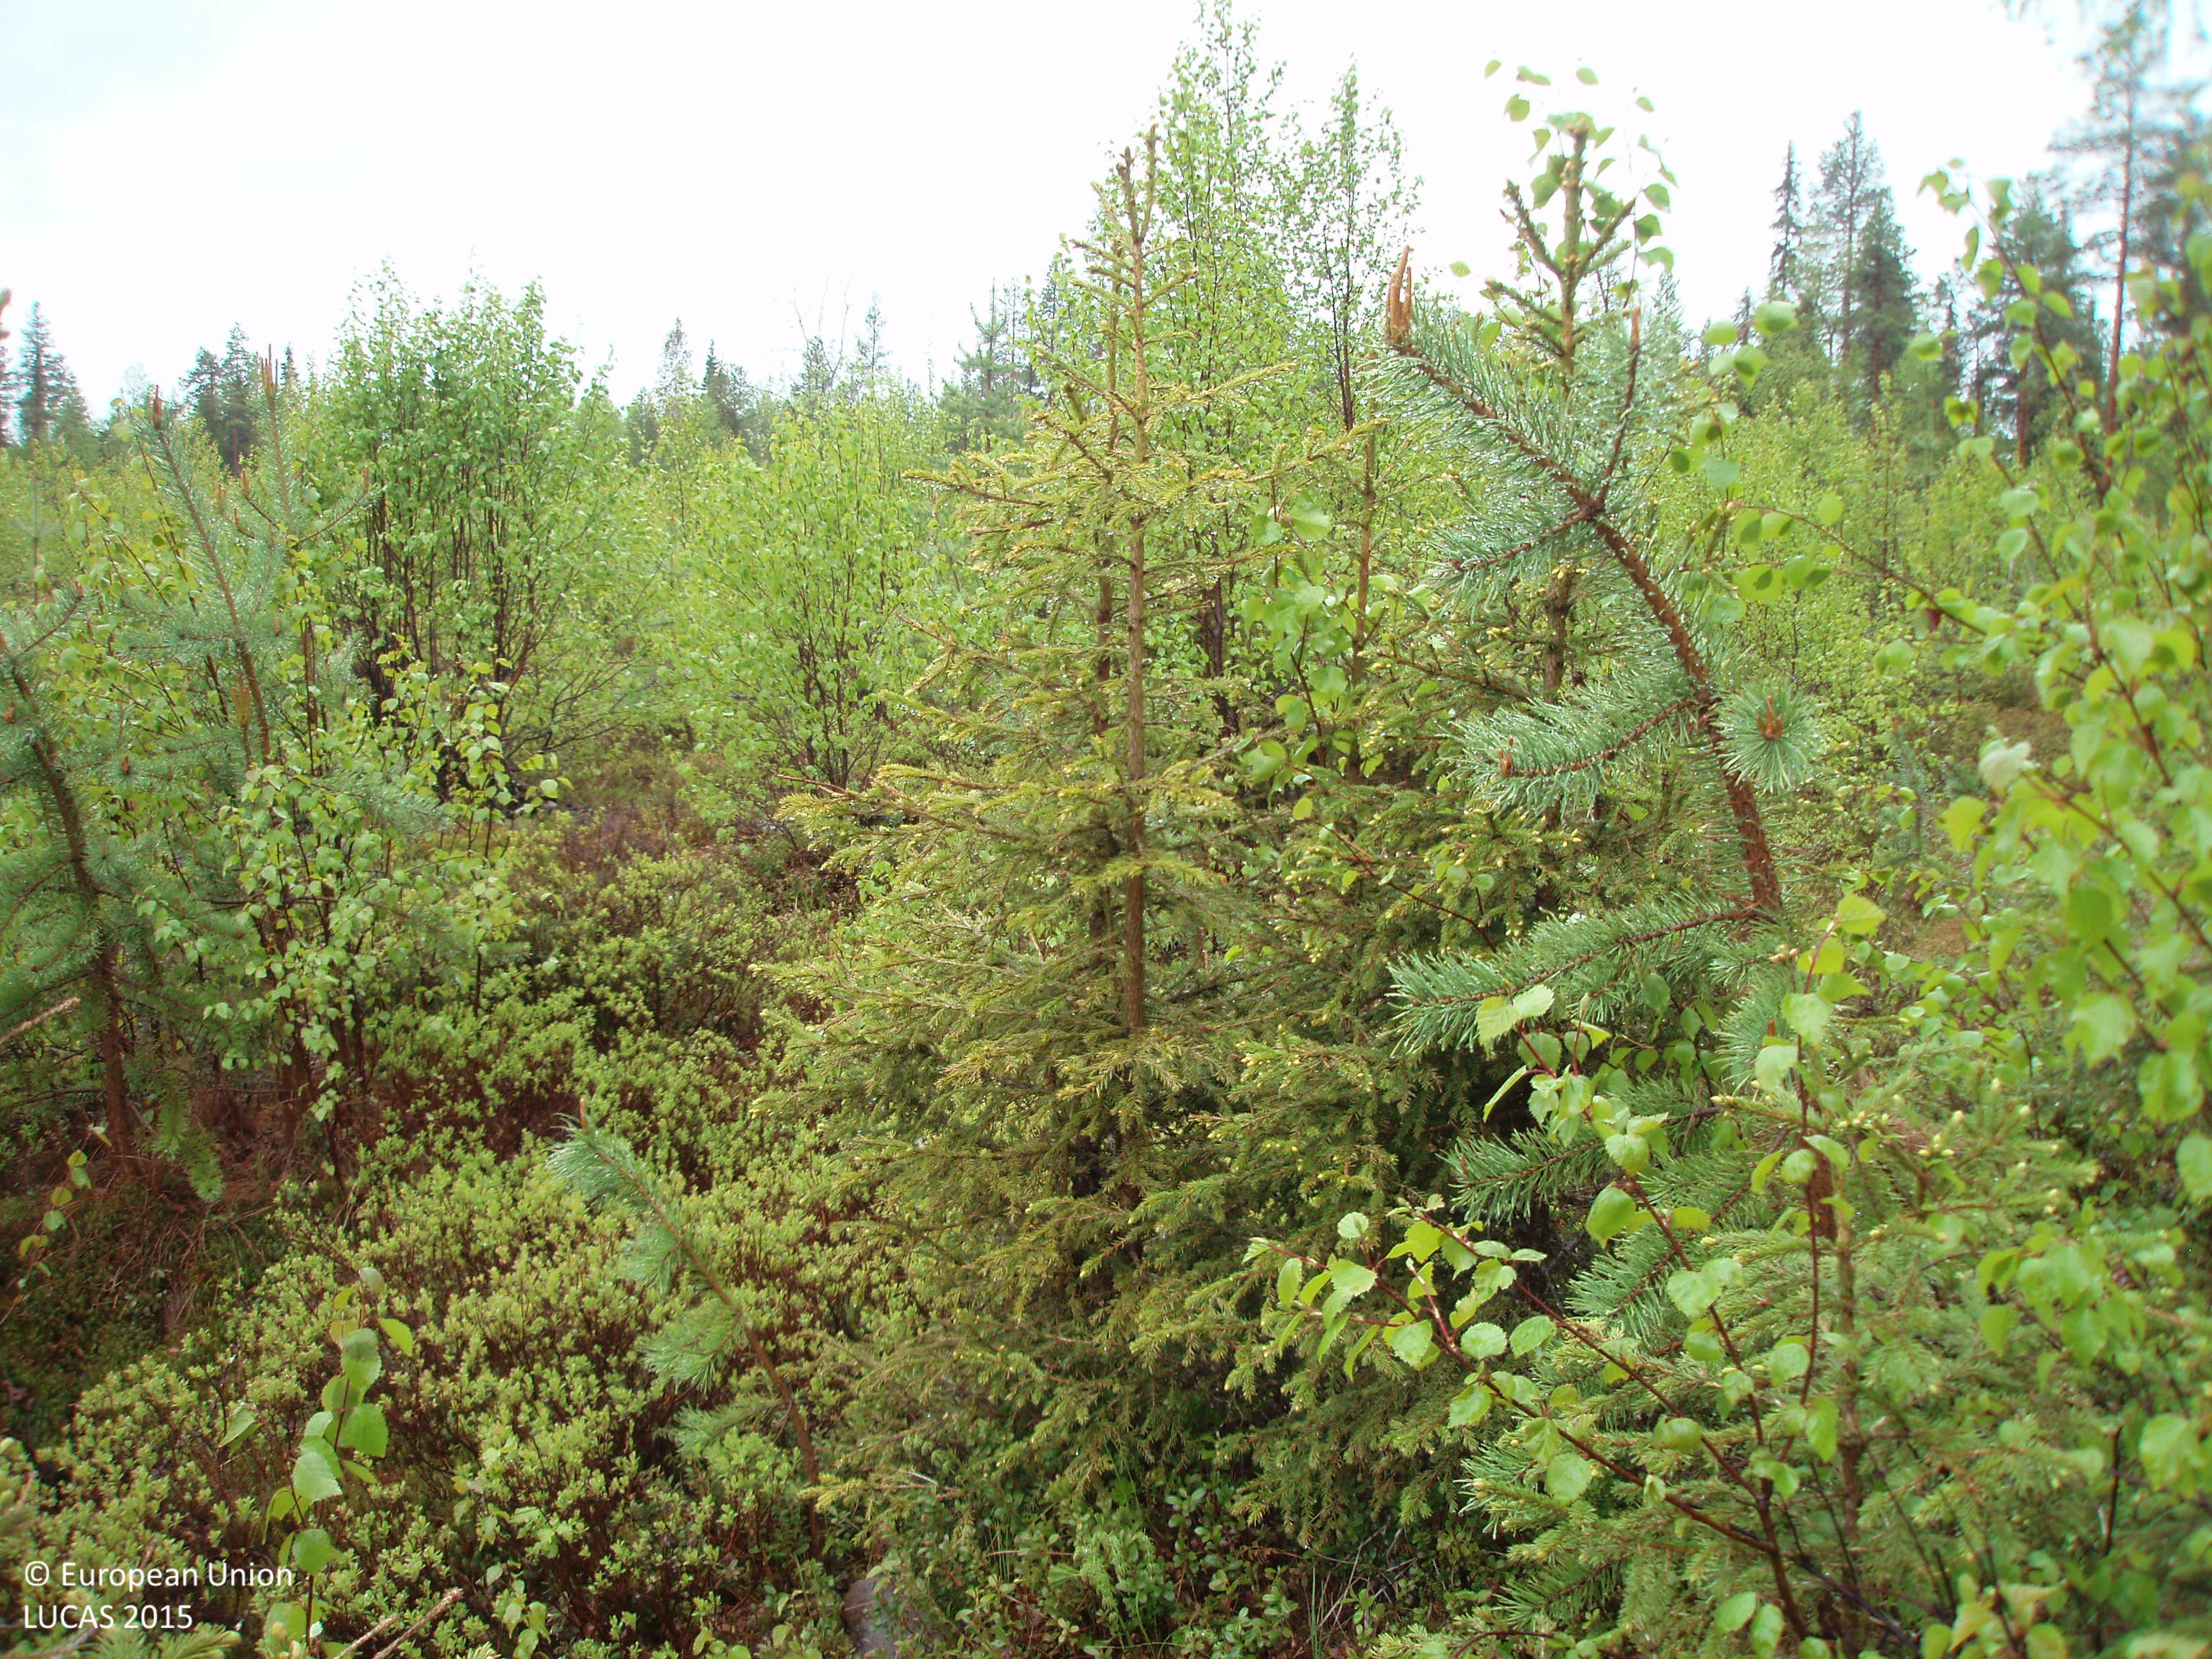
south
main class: Woodland
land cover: Other mixed woodland
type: boreal forest
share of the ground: > 75 %
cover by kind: broadleaved forest trees 60 %, coniferous forest trees 25 %, shrubs 10 %, herbaceous plants 5 %
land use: Forestry
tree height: < 5 m
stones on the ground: < 10 %
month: June
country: FI
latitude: 67.4293
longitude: 26.4851
